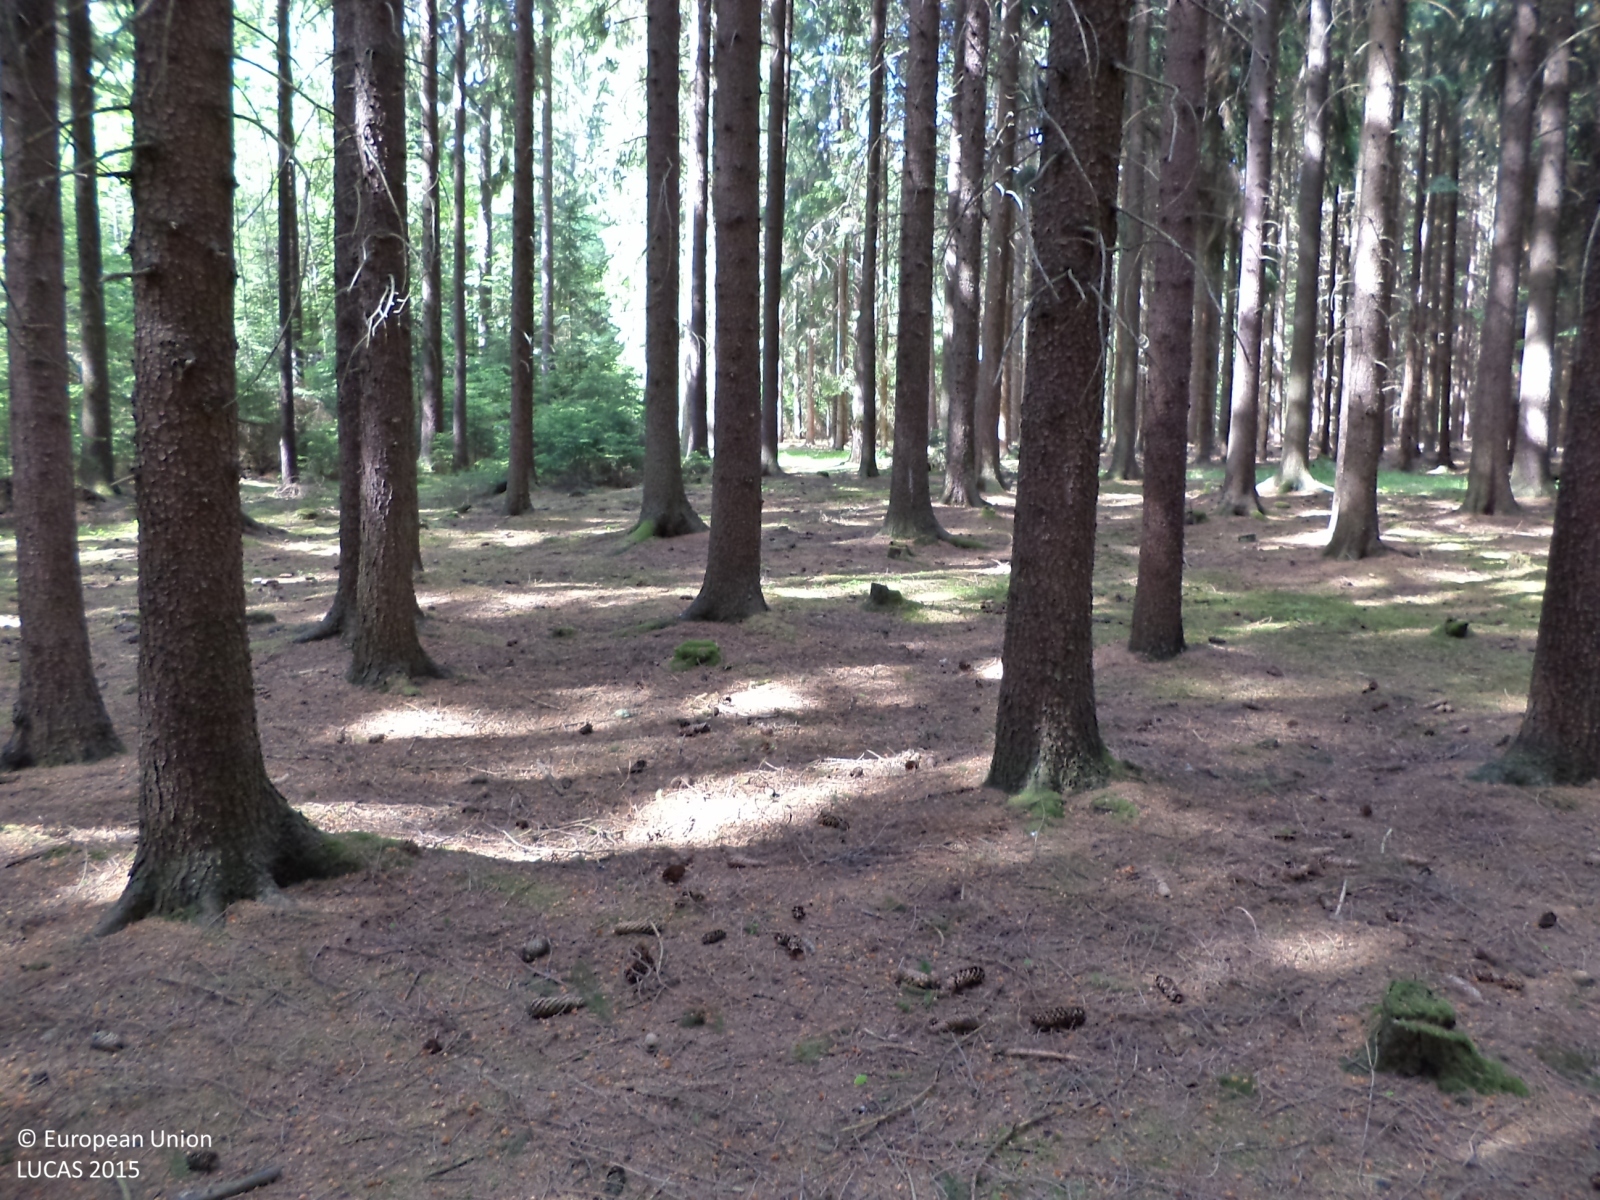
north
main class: Woodland
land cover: Spruce dominated coniferous woodland
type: hemiboreal forest and nemoral coniferous forest and mixed broadleaved-coniferous forest
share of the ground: > 75 %
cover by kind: coniferous forest trees 95 %, lichens and mosses 5 %
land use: Forestry
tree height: > 5 m
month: June
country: CZ
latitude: 49.6192
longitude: 15.1104
